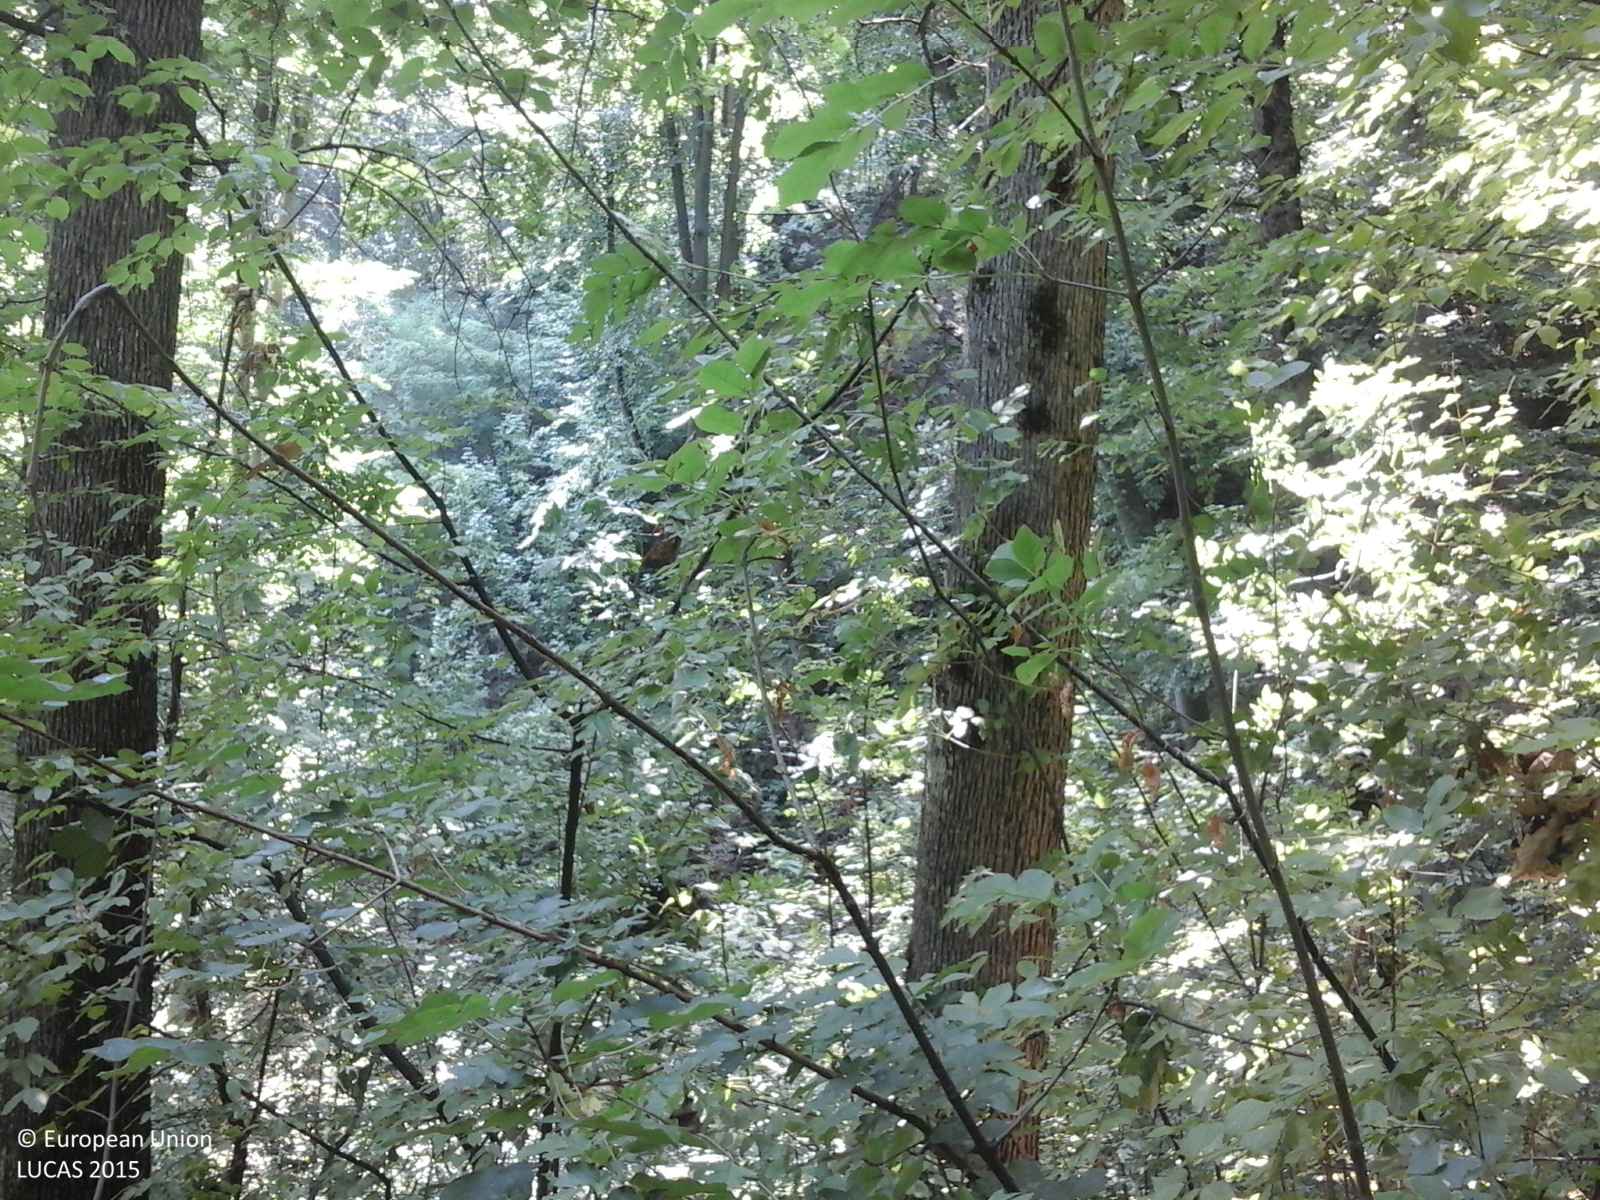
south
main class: Woodland
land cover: Broadleaved woodland
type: mesophytic deciduous forest
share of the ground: > 75 %
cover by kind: broadleaved forest trees 100 %
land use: Forestry
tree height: > 5 m
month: August
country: RO
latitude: 44.7009
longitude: 23.1108
